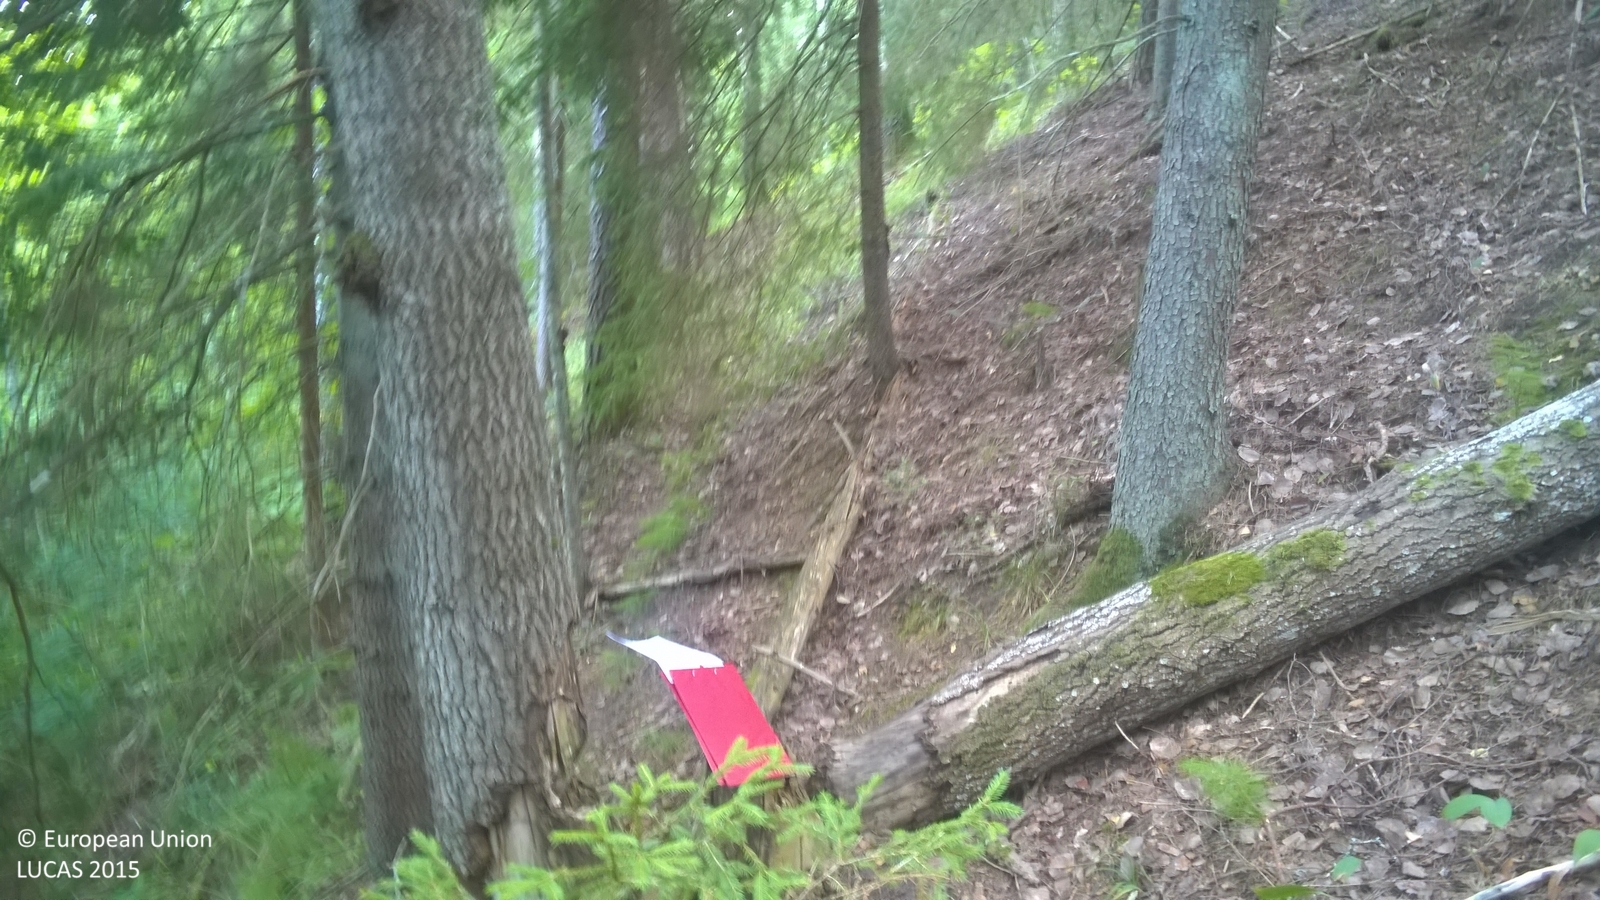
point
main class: Woodland
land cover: Other mixed woodland
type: hemiboreal forest and nemoral coniferous forest and mixed broadleaved-coniferous forest
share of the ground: > 75 %
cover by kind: coniferous forest trees 50 %, broadleaved forest trees 35 %, herbaceous plants 5 %, lichens and mosses 5 %, unconsolidated bare surface 5 %
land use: Forestry
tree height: > 5 m
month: August
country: LV
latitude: 57.7046
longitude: 26.0541
